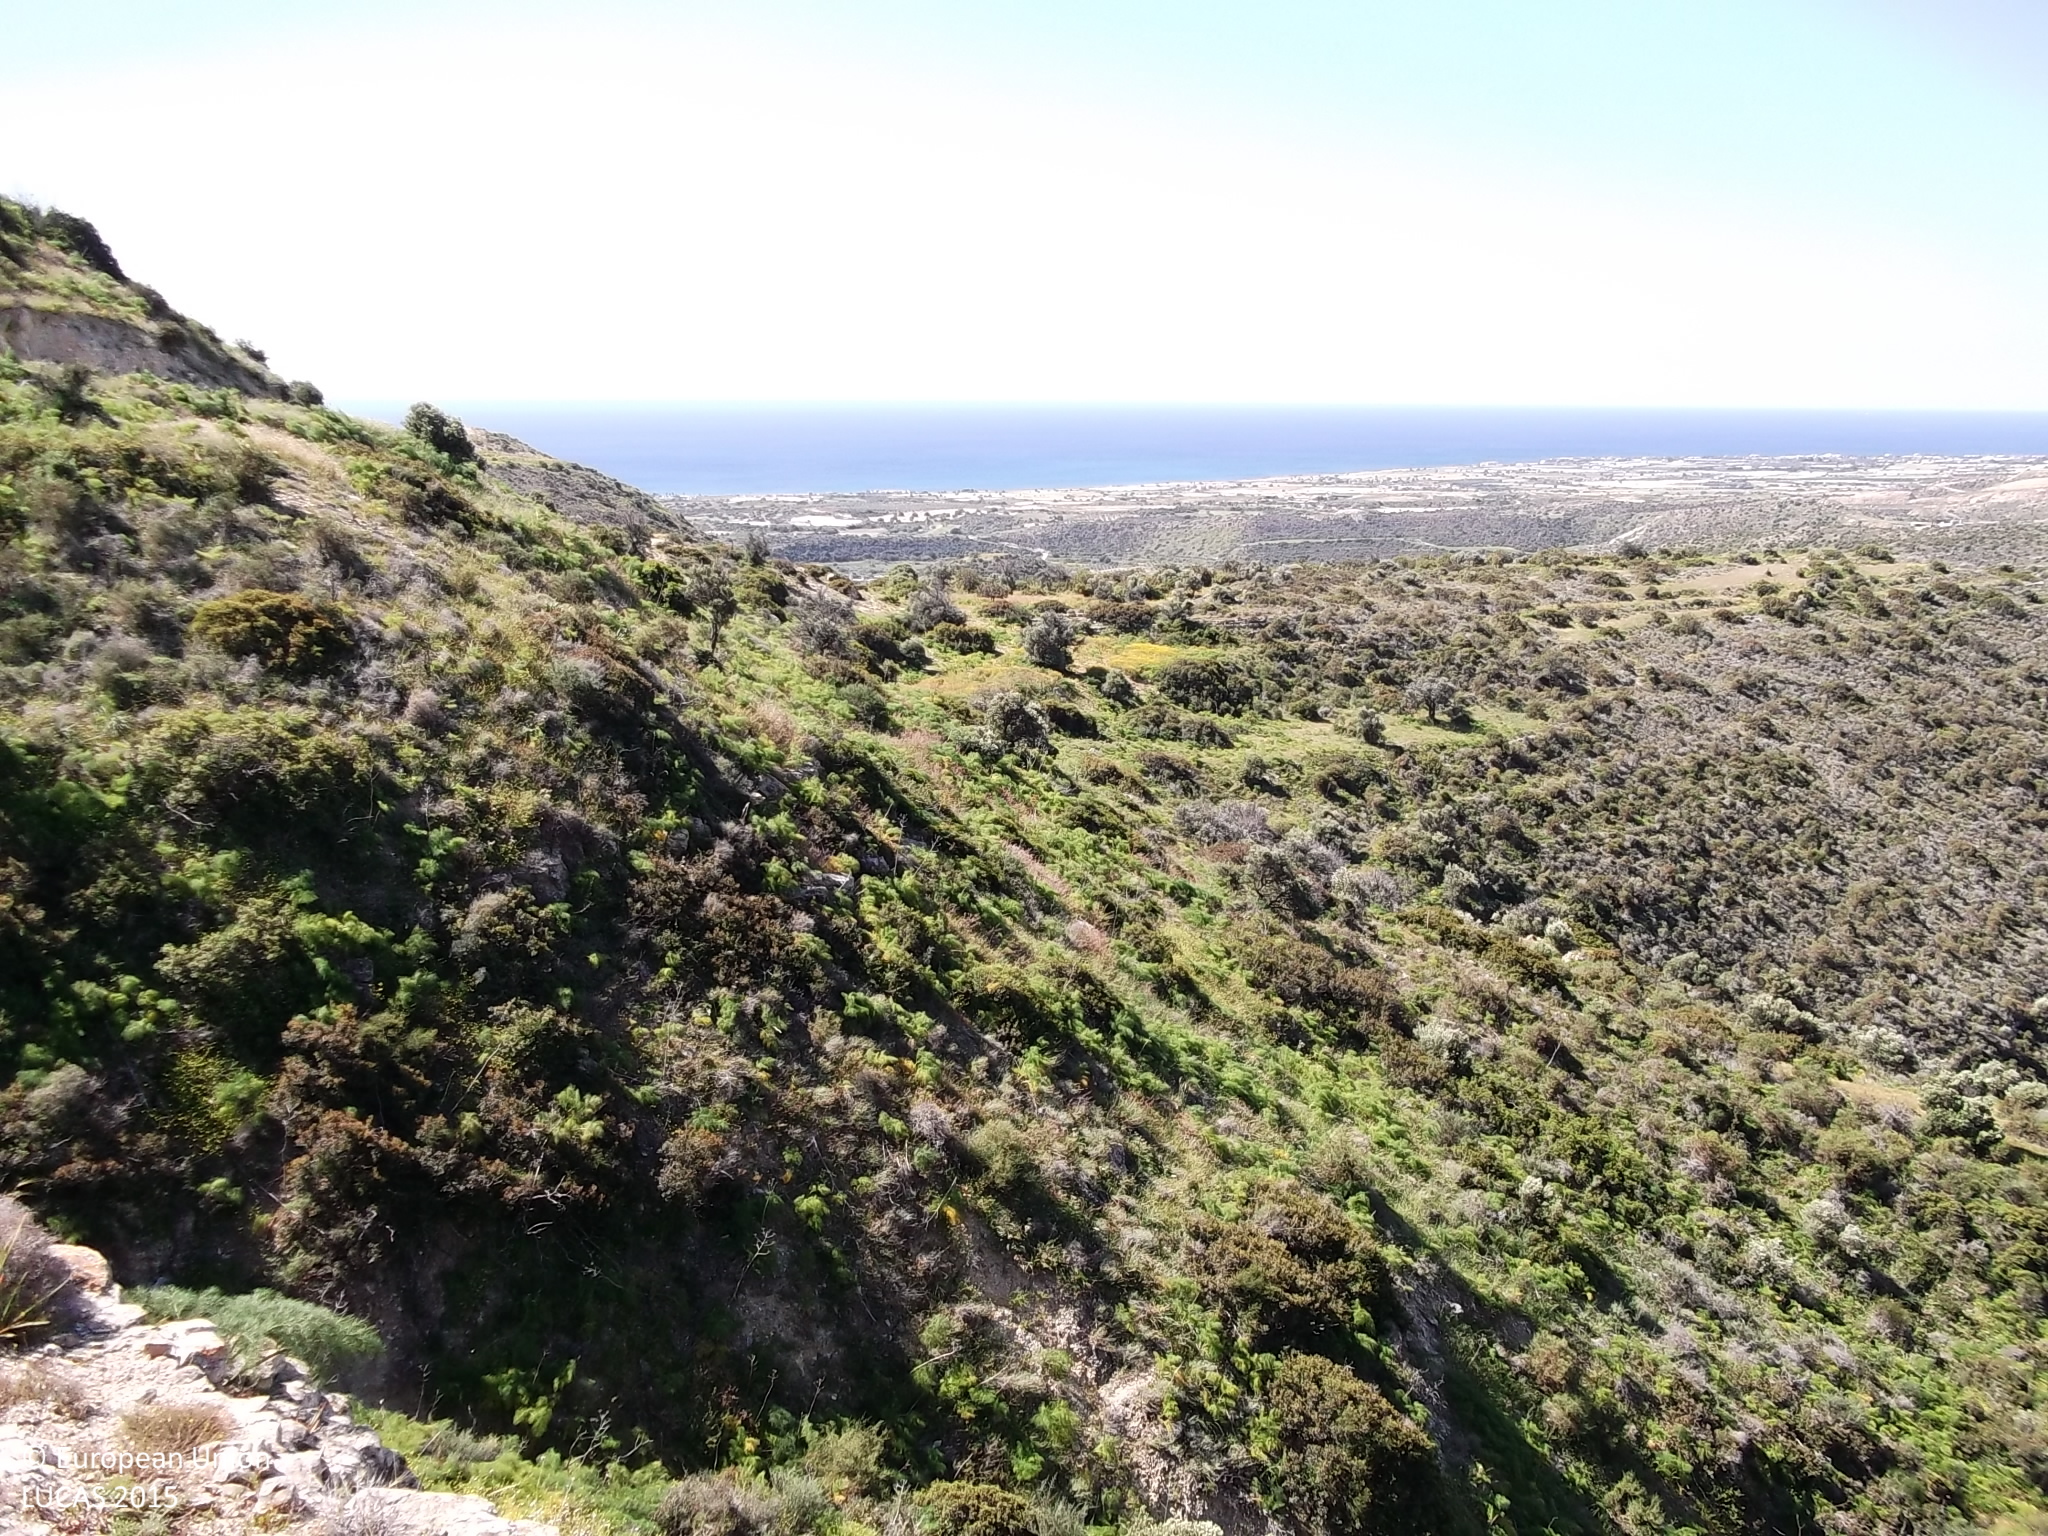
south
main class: Shrubland
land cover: Shrubland with sparse tree cover
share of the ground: 50 - 75 %
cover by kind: shrubs 45 %, herbaceous plants 40 %, unconsolidated bare surface 10 %, broadleaved forest trees 5 %
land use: Semi-natural and natural areas not in use
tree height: < 5 m
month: April
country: CY
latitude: 34.7833
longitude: 33.4046
